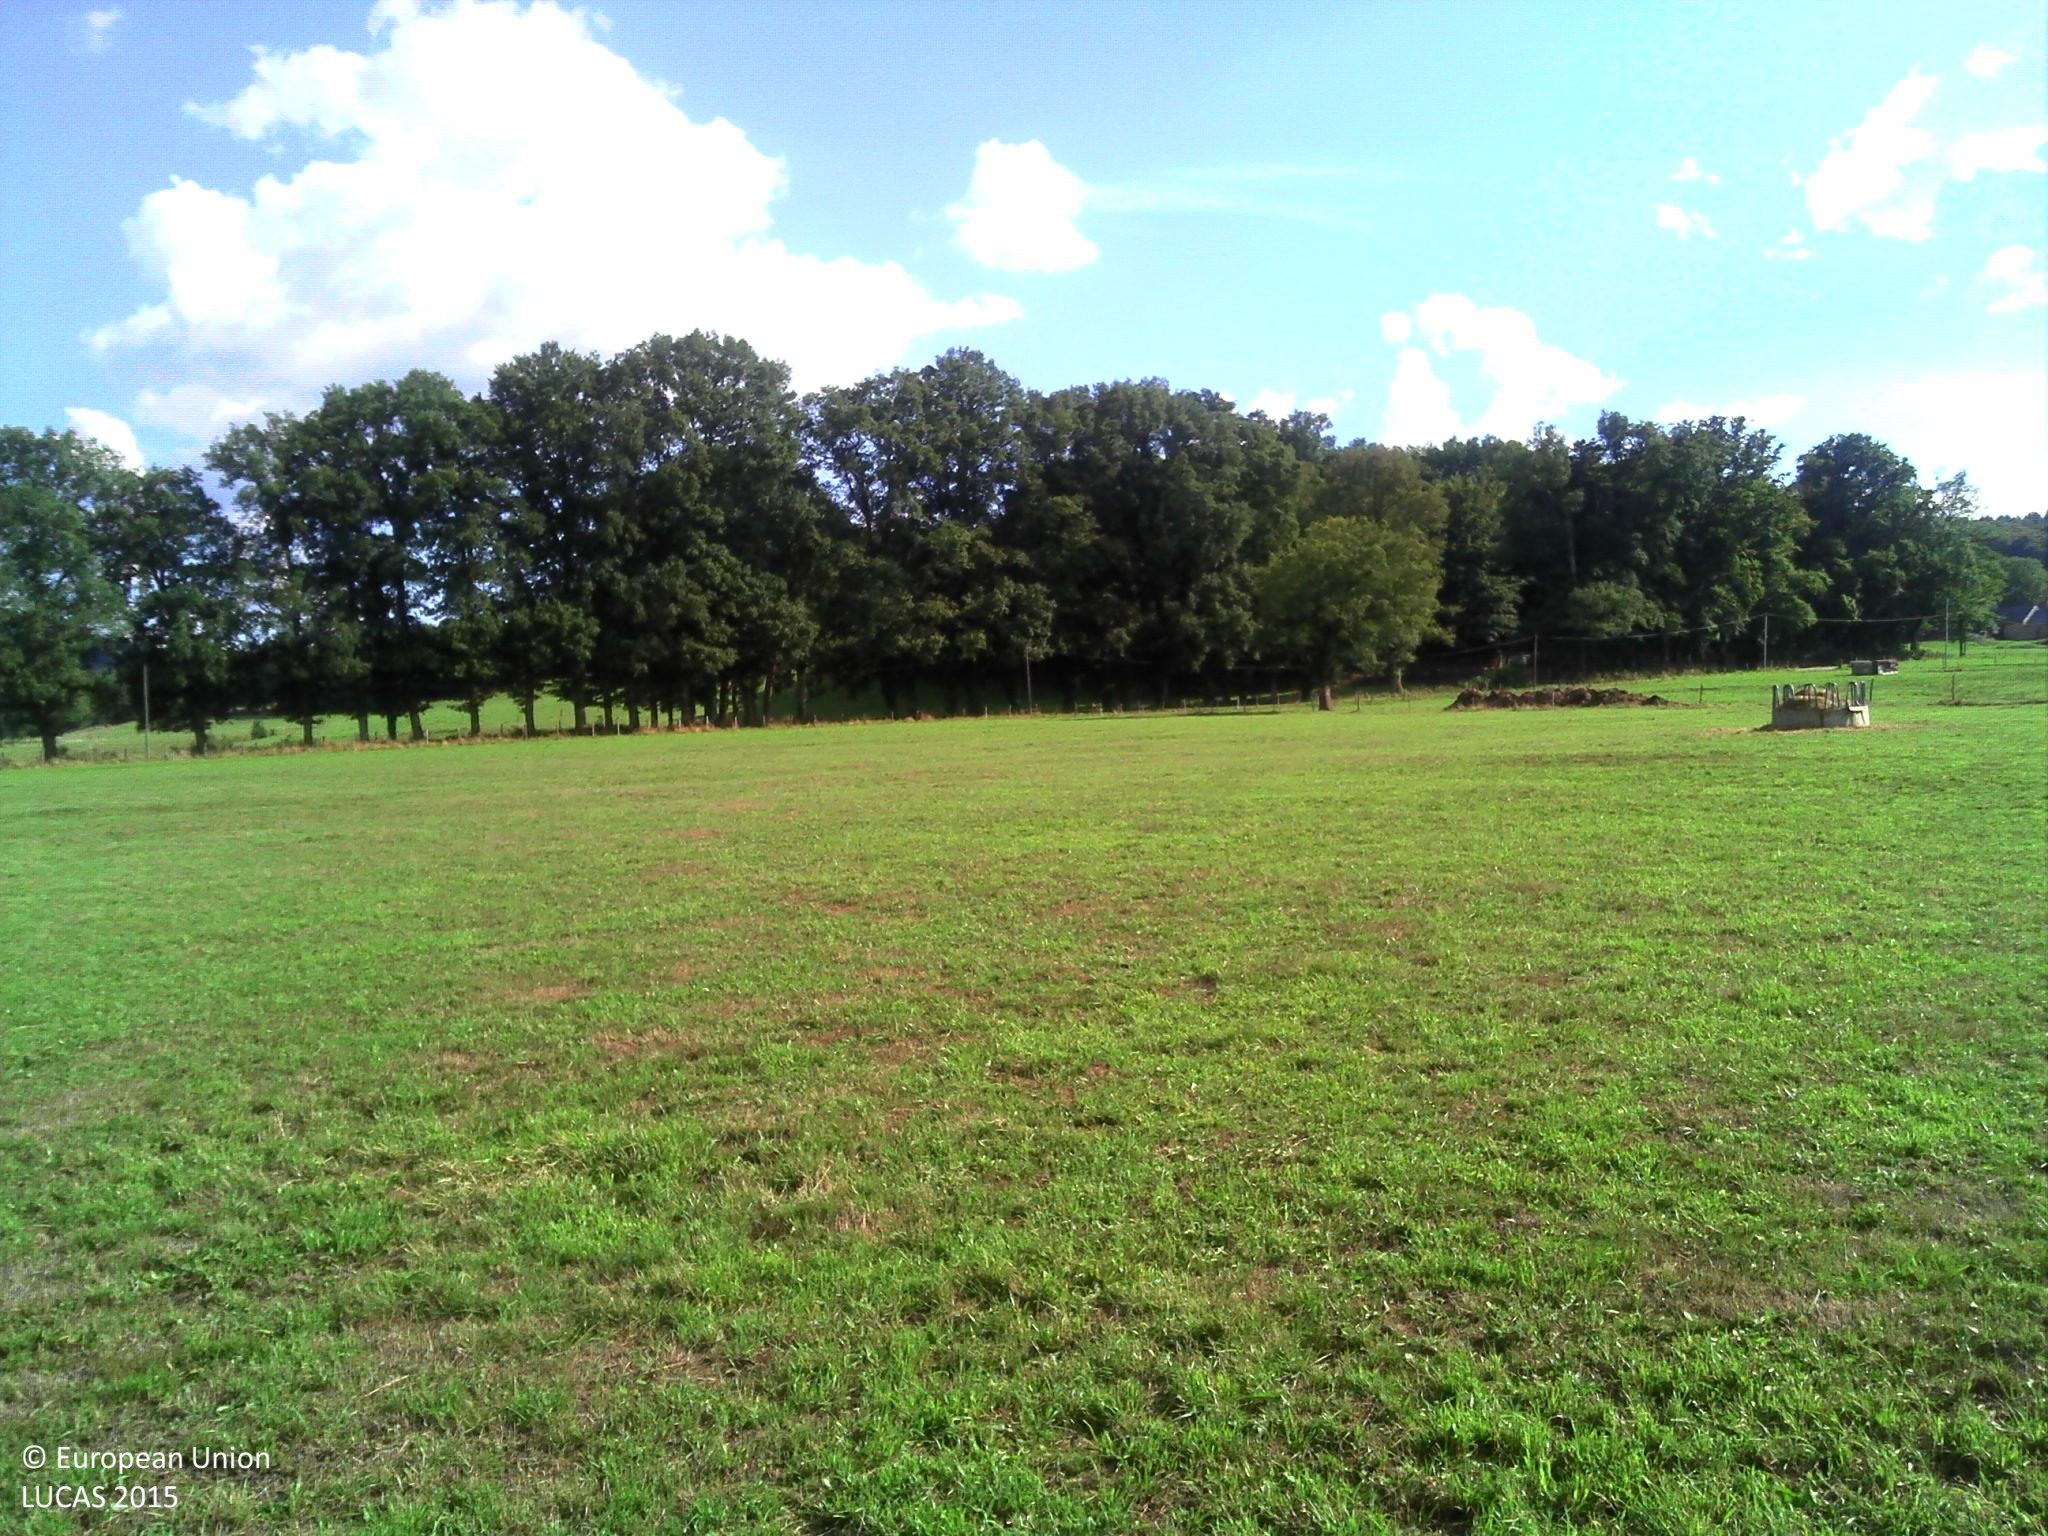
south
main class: Grassland
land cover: Grassland without tree/shrub cover
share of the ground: > 75 %
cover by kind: herbaceous plants 100 %
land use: Agriculture (excluding fallow land and kitchen gardens)
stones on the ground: < 10 %
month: August
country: FR
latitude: 45.9377
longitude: 1.6996
